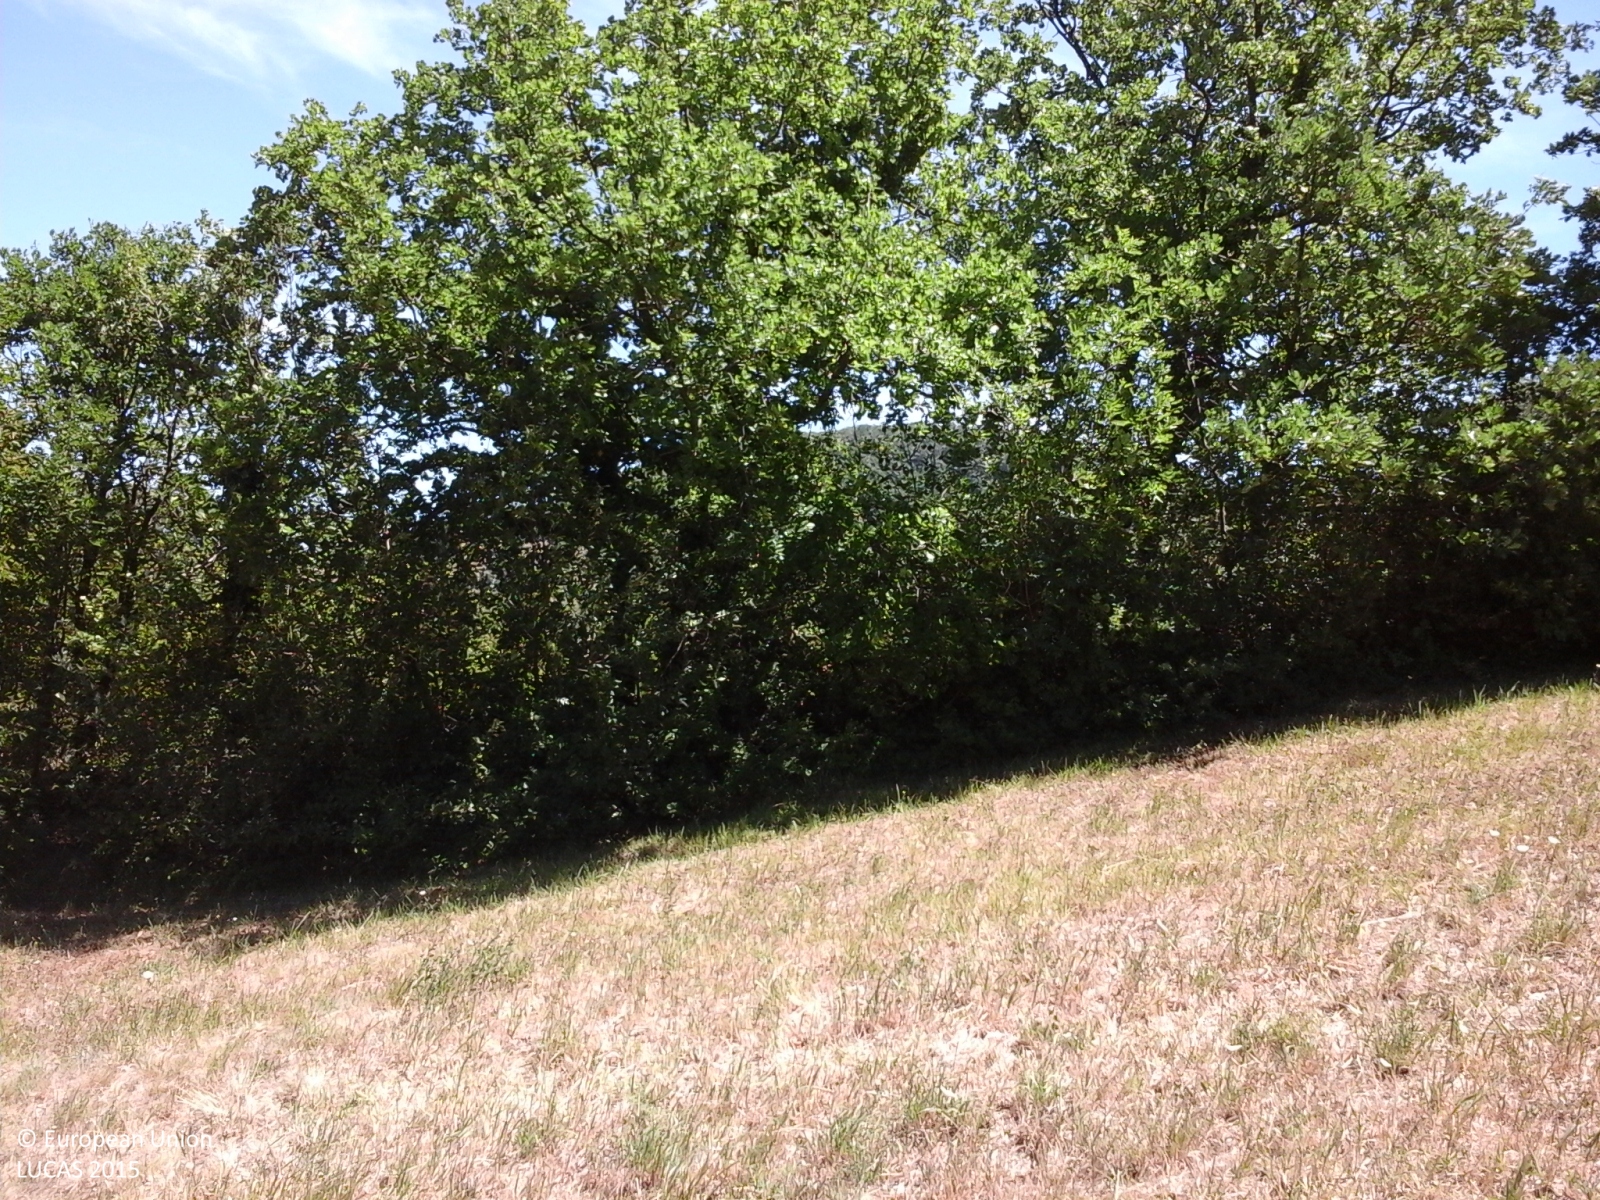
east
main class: Grassland
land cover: Grassland without tree/shrub cover
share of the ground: > 75 %
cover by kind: herbaceous plants 100 %
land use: Agriculture (excluding fallow land and kitchen gardens)
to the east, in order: Grassland without tree/shrub cover; Broadleaved woodland; Grassland without tree/shrub cover; Broadleaved woodland; Grassland without tree/shrub cover; Broadleaved woodland; Electric lines; Broadleaved woodland; Grassland without tree/shrub cover
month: July
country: IT
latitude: 41.4928
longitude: 14.3562
